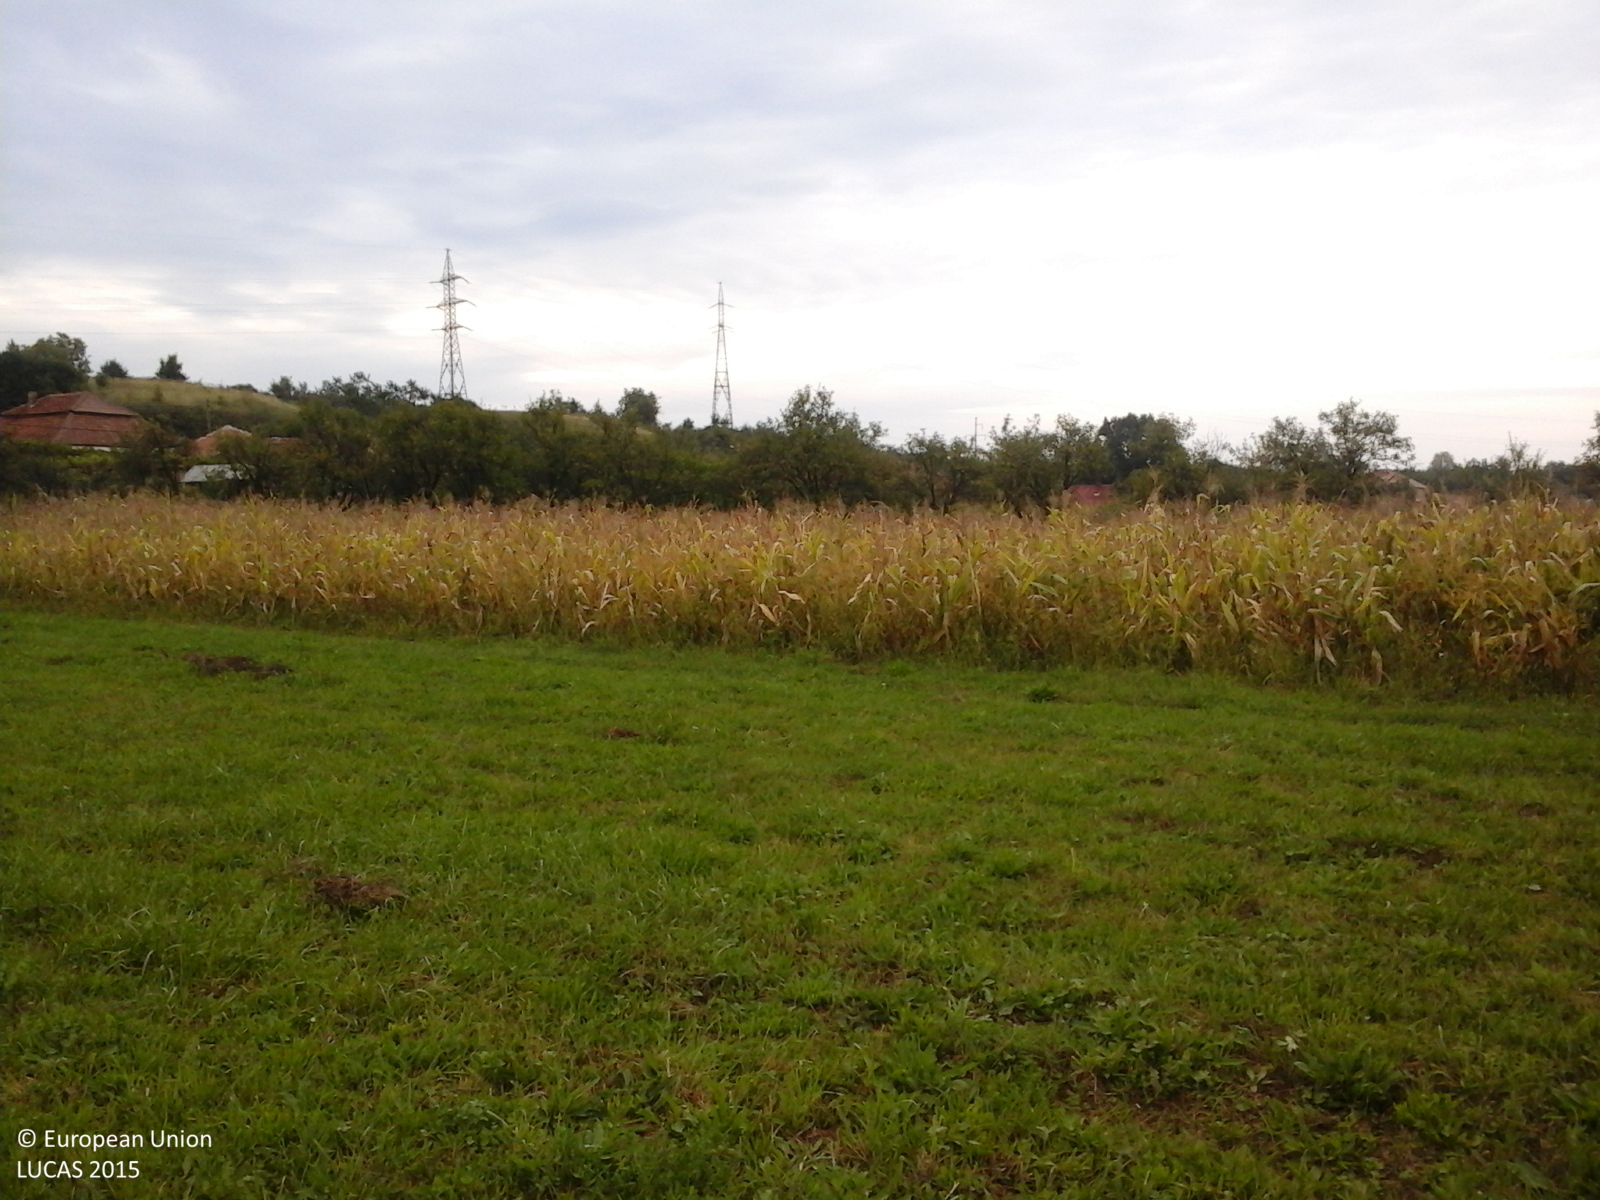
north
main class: Grassland
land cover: Grassland without tree/shrub cover
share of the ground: > 75 %
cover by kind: herbaceous plants 100 %
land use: Agriculture (excluding fallow land and kitchen gardens)
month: September
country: RO
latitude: 47.2286
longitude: 22.4031
